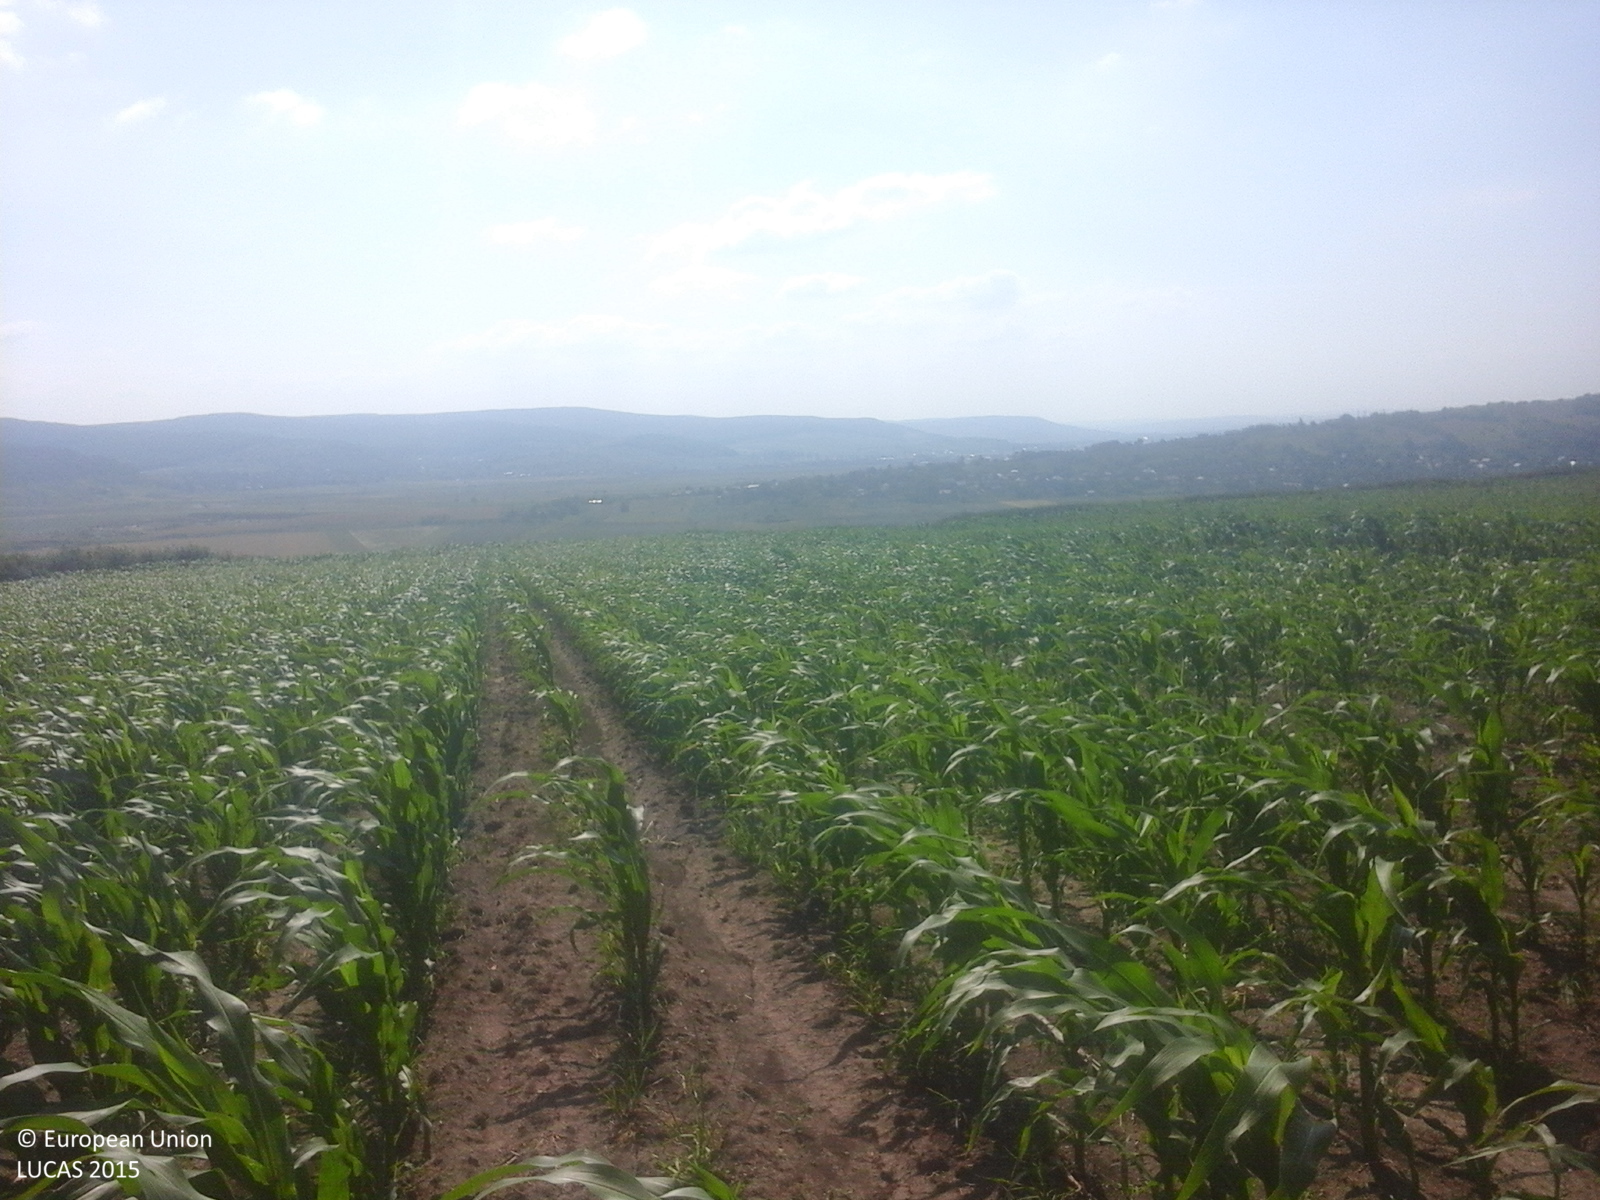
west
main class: Cropland
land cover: Maize
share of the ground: 25 - 50 %
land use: Agriculture (excluding fallow land and kitchen gardens)
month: June
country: RO
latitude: 46.8259
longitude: 27.5088
